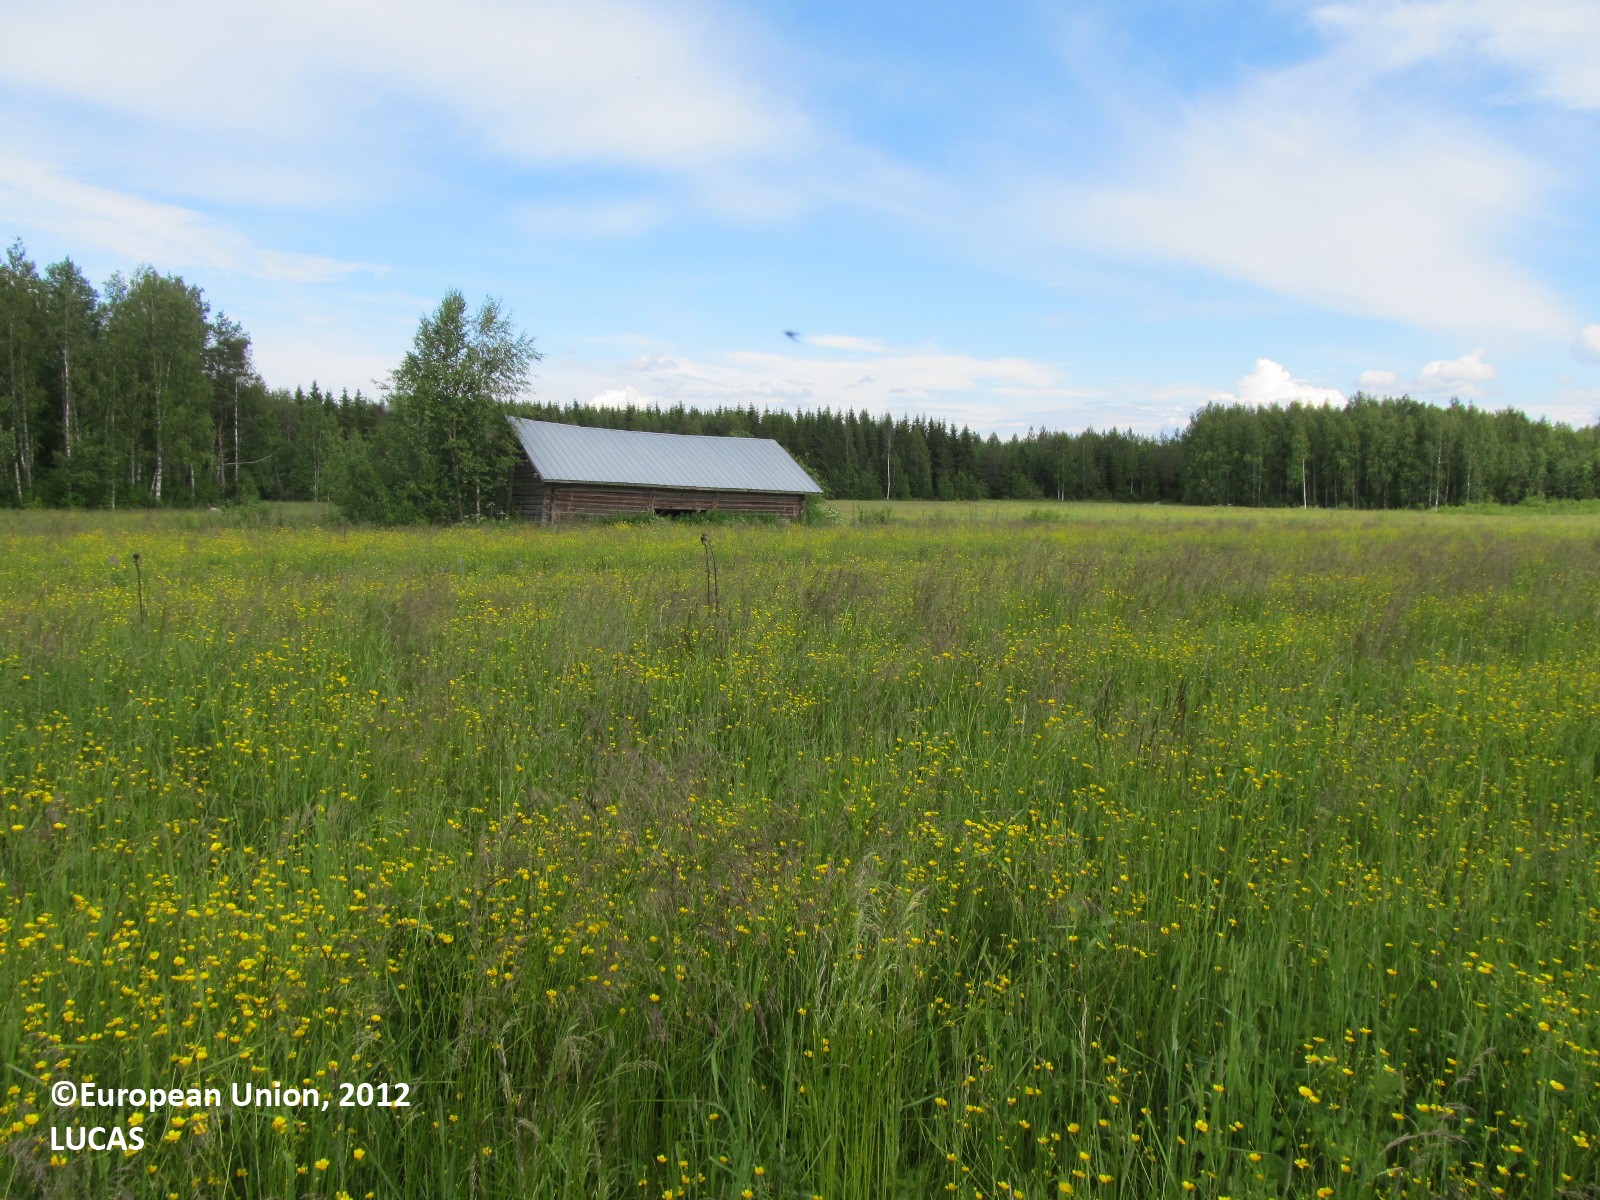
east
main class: Grassland
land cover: Grassland without tree/shrub cover
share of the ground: > 75 %
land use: Agriculture (excluding fallow land and kitchen gardens)
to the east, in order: Grassland without tree/shrub cover; Ditches and canals; Grassland without tree/shrub cover; Artificial constructions in urban areas; Ditches and canals; Grassland without tree/shrub cover; Ditches and canals; Grassland without tree/shrub cover; Ditches and canals; Grassland without tree/shrub cover; Ditches and canals; Grassland without tree/shrub cover; Ditches and canals; Grassland without tree/shrub cover; Ditches and canals; Temporary grasslands
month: June
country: FI
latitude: 62.8092
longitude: 29.2329
